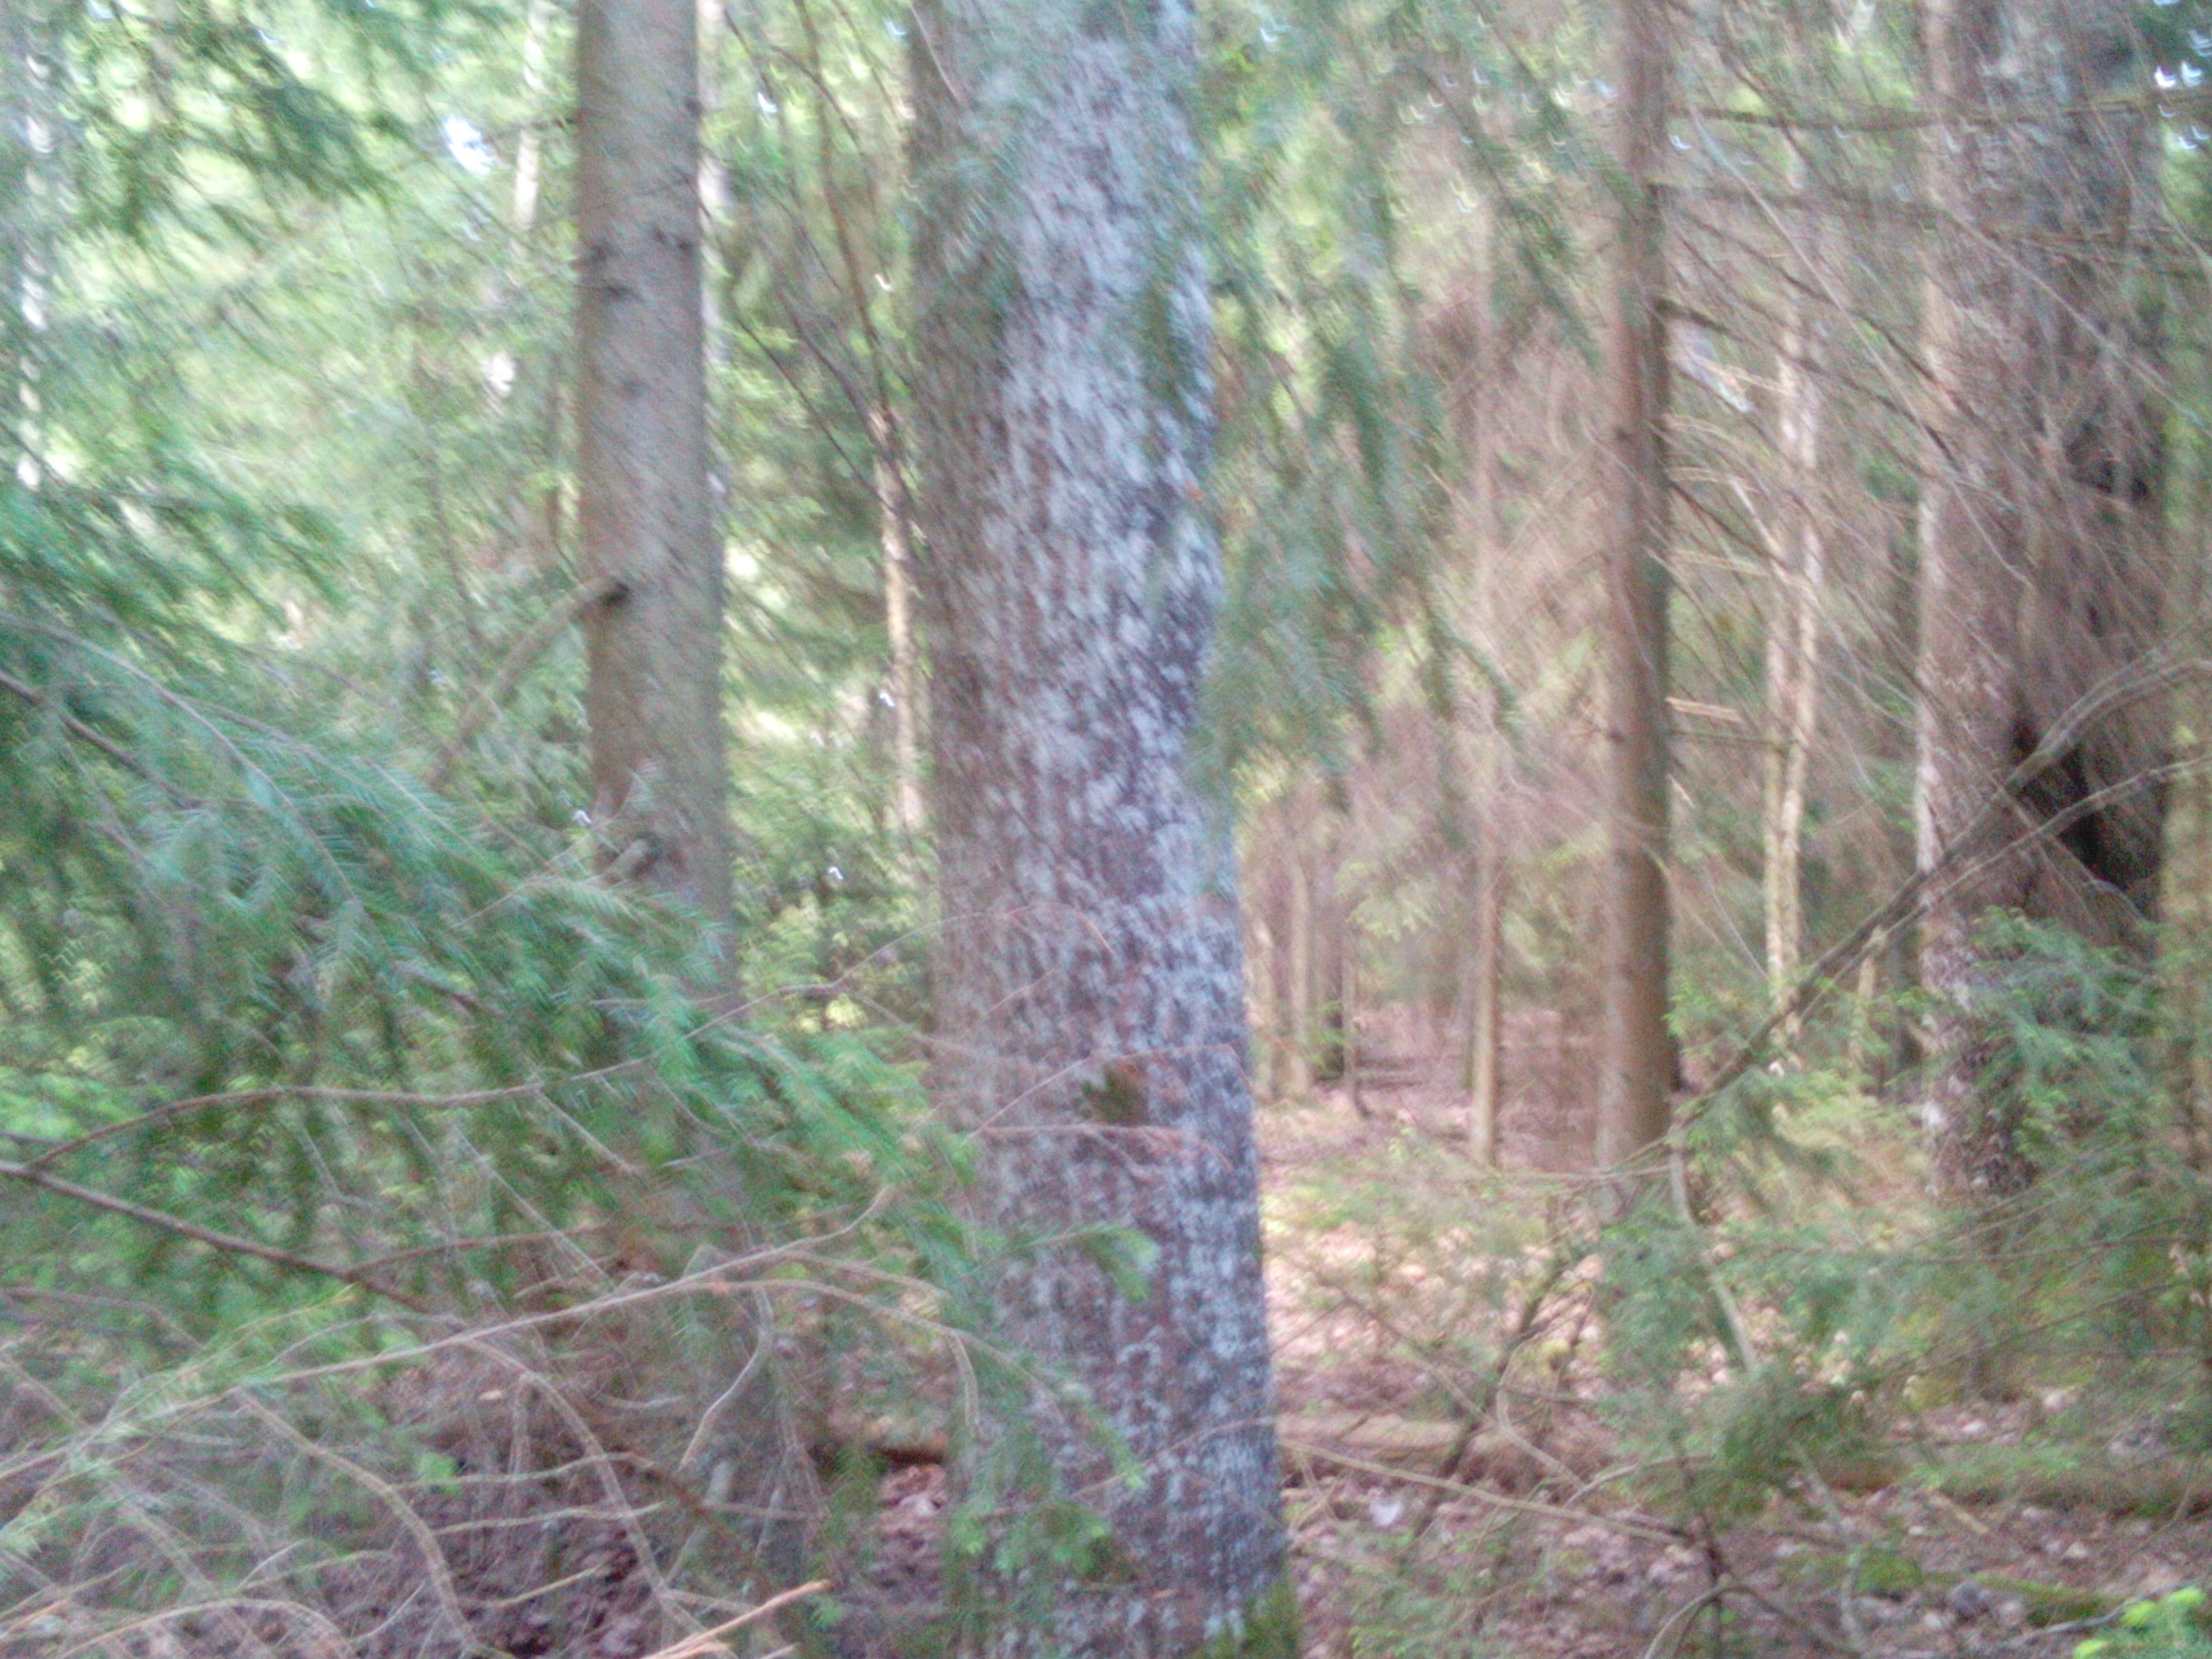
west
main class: Woodland
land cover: Spruce dominated mixed woodland
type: hemiboreal forest and nemoral coniferous forest and mixed broadleaved-coniferous forest
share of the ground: > 75 %
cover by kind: broadleaved forest trees 50 %, coniferous forest trees 40 %, herbaceous plants 10 %
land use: Forestry
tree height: > 5 m
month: June
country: LV
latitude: 56.6733
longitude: 22.2433
